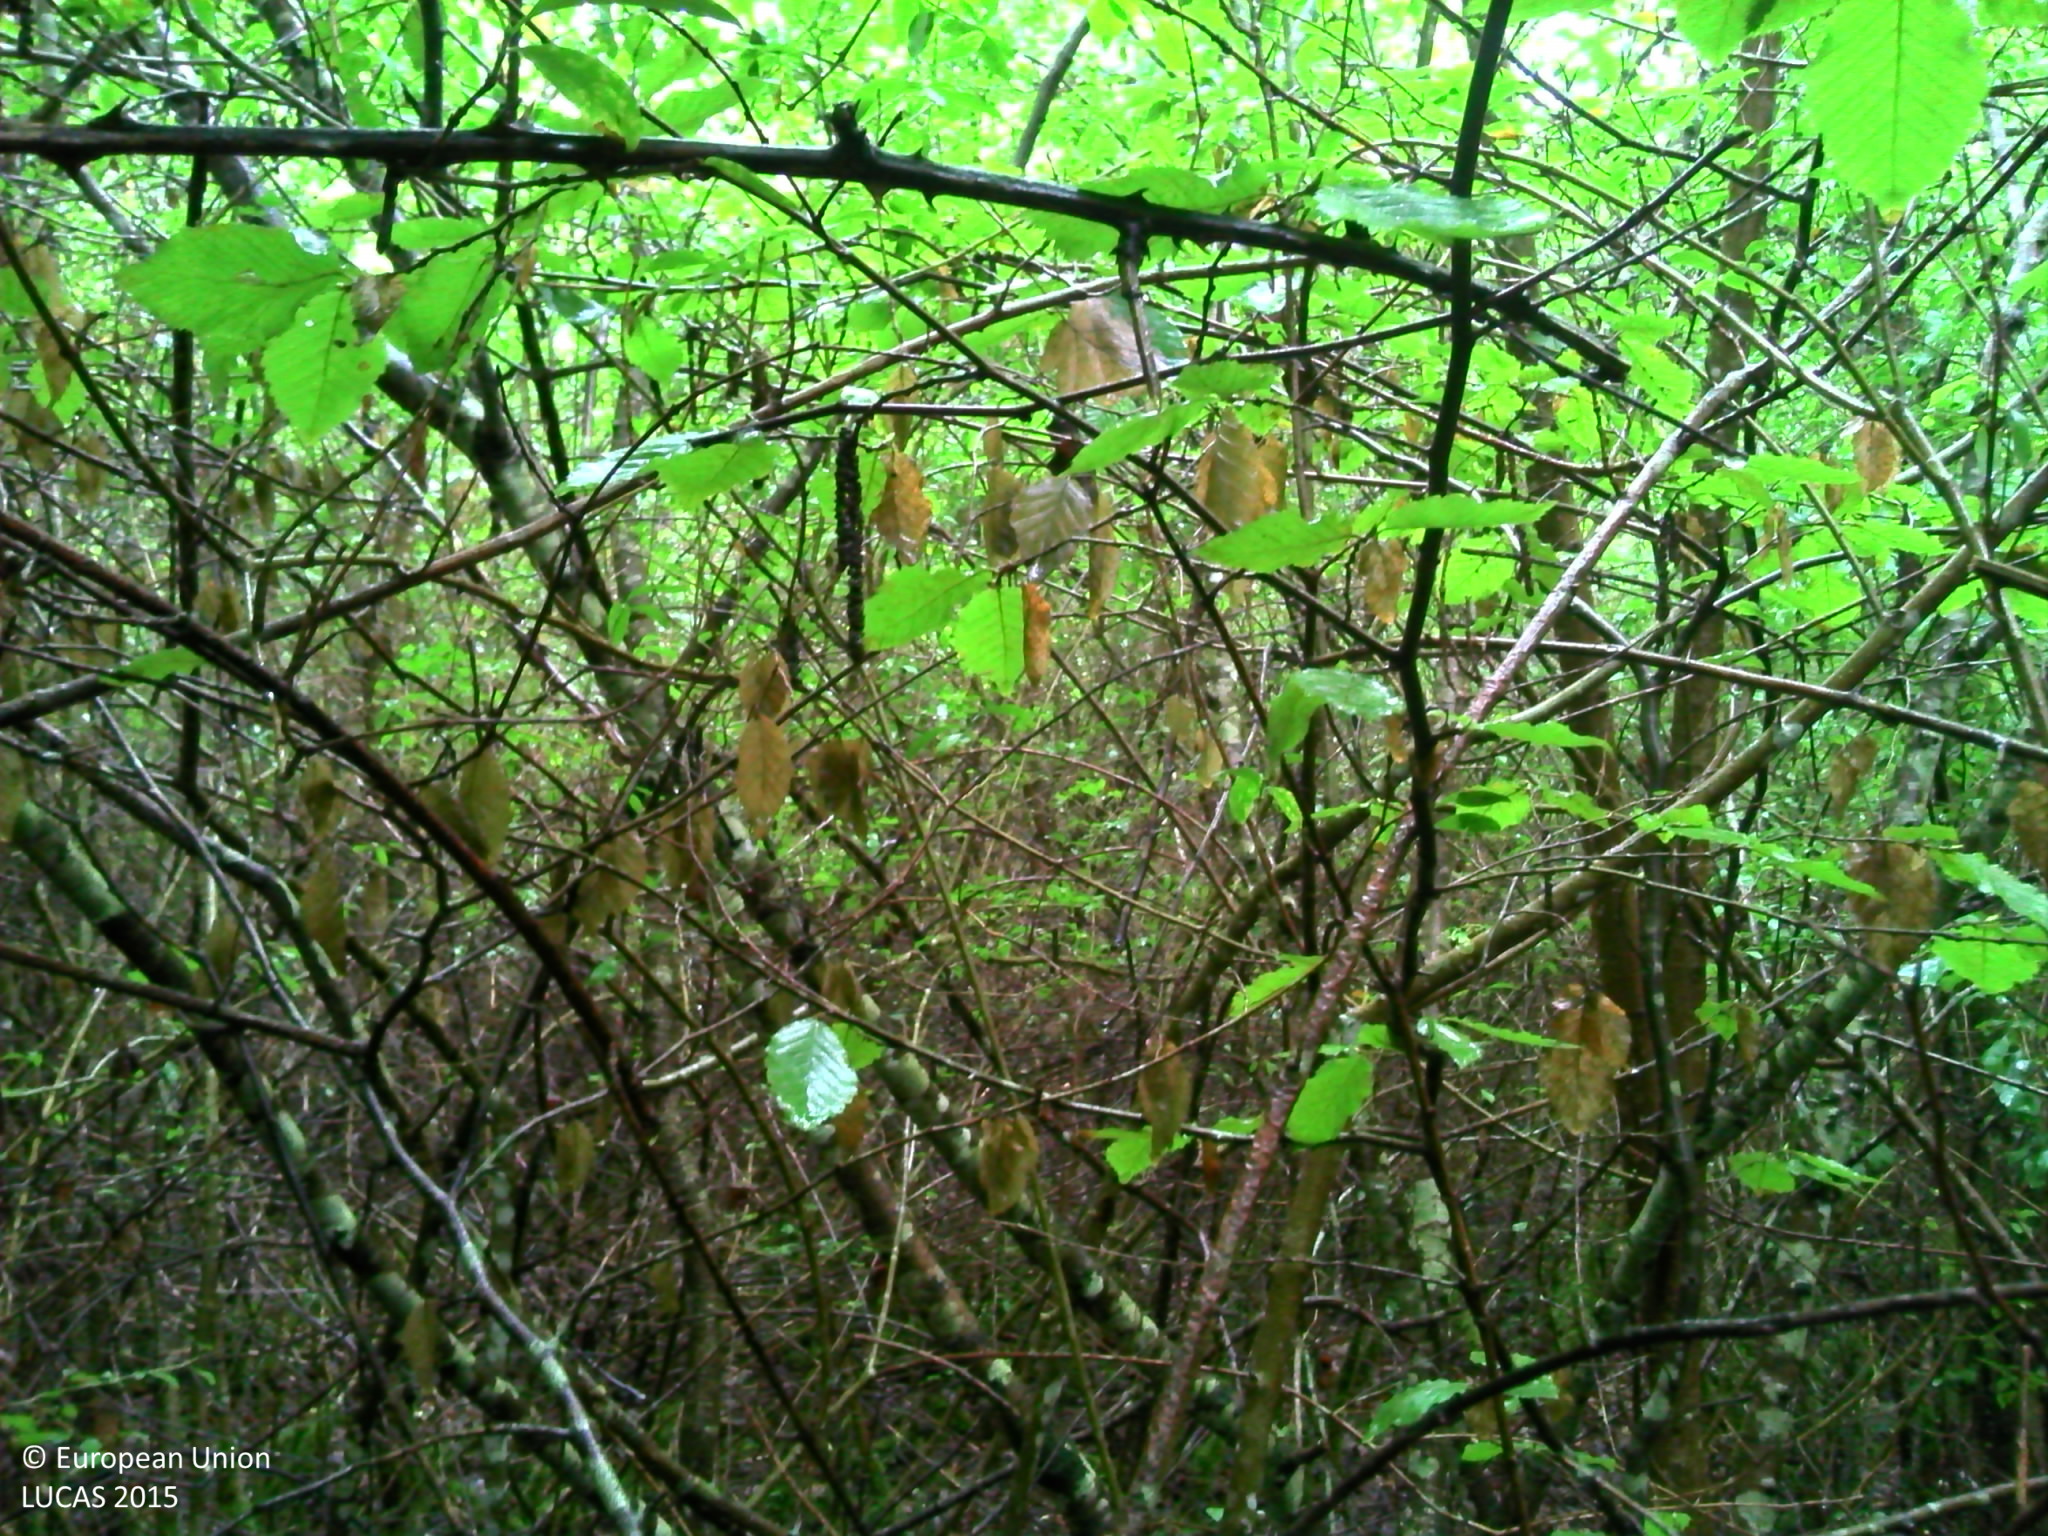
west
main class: Woodland
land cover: Broadleaved woodland
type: mesophytic deciduous forest
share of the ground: > 75 %
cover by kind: broadleaved forest trees 80 %, shrubs 15 %, herbaceous plants 5 %
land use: Forestry
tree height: > 5 m
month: September
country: FR
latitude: 47.1049
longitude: 4.7164
